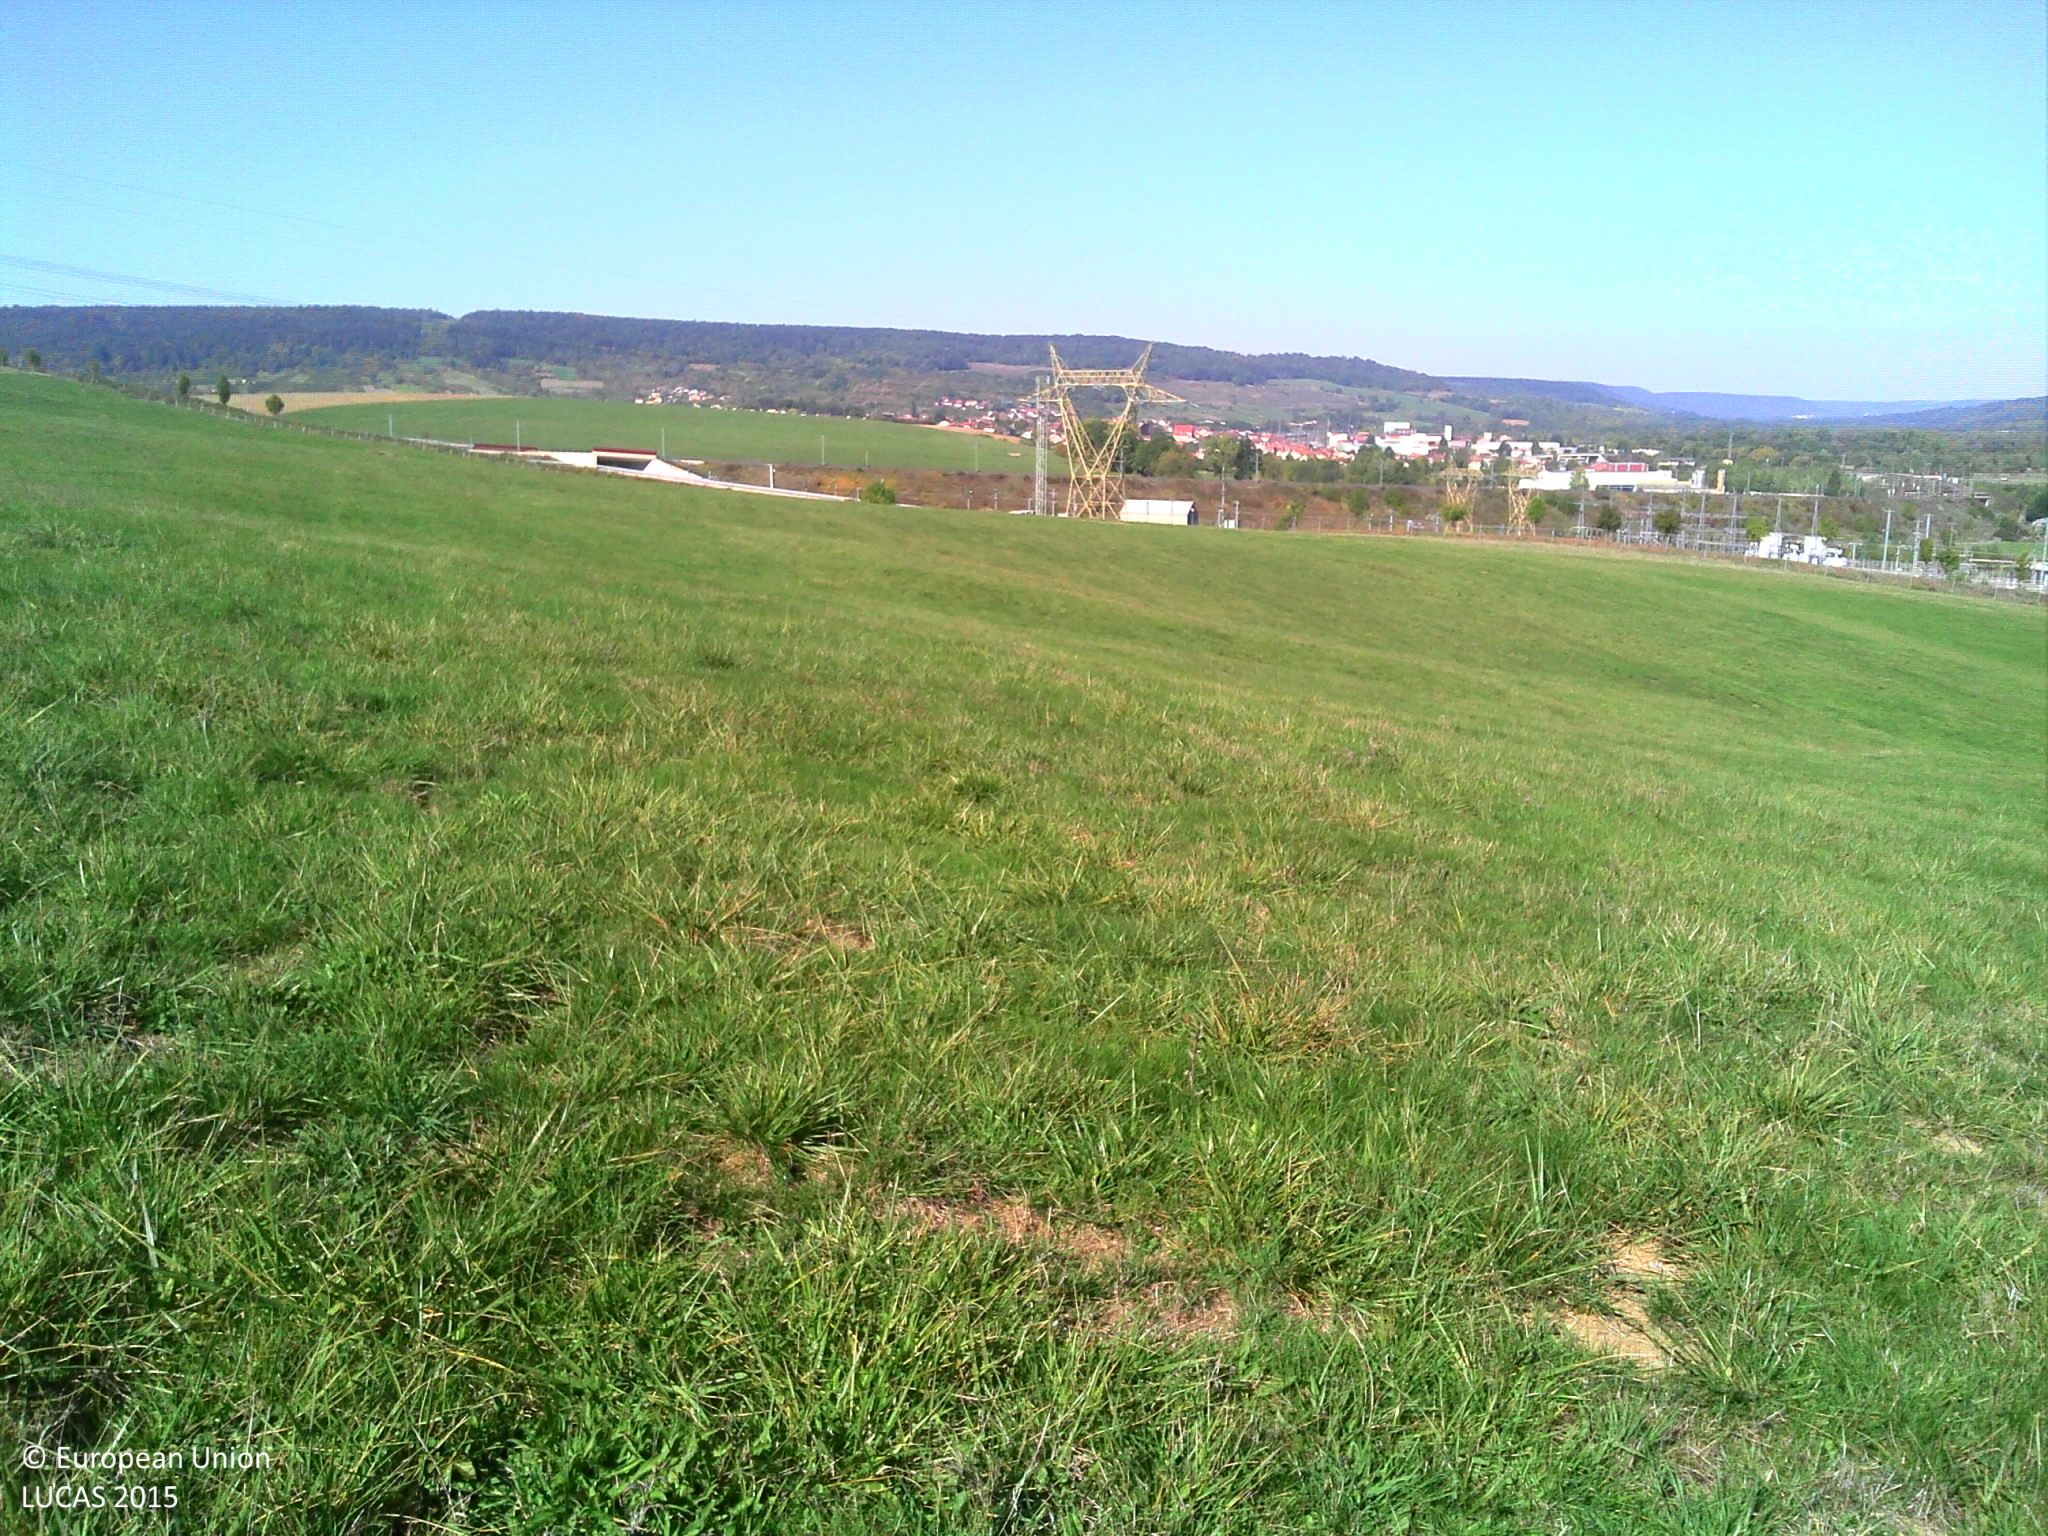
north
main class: Grassland
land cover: Grassland without tree/shrub cover
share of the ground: > 75 %
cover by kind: herbaceous plants 95 %, consolidated bare surface 5 %
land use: Agriculture (excluding fallow land and kitchen gardens)
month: October
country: FR
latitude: 48.9625
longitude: 6.0250
